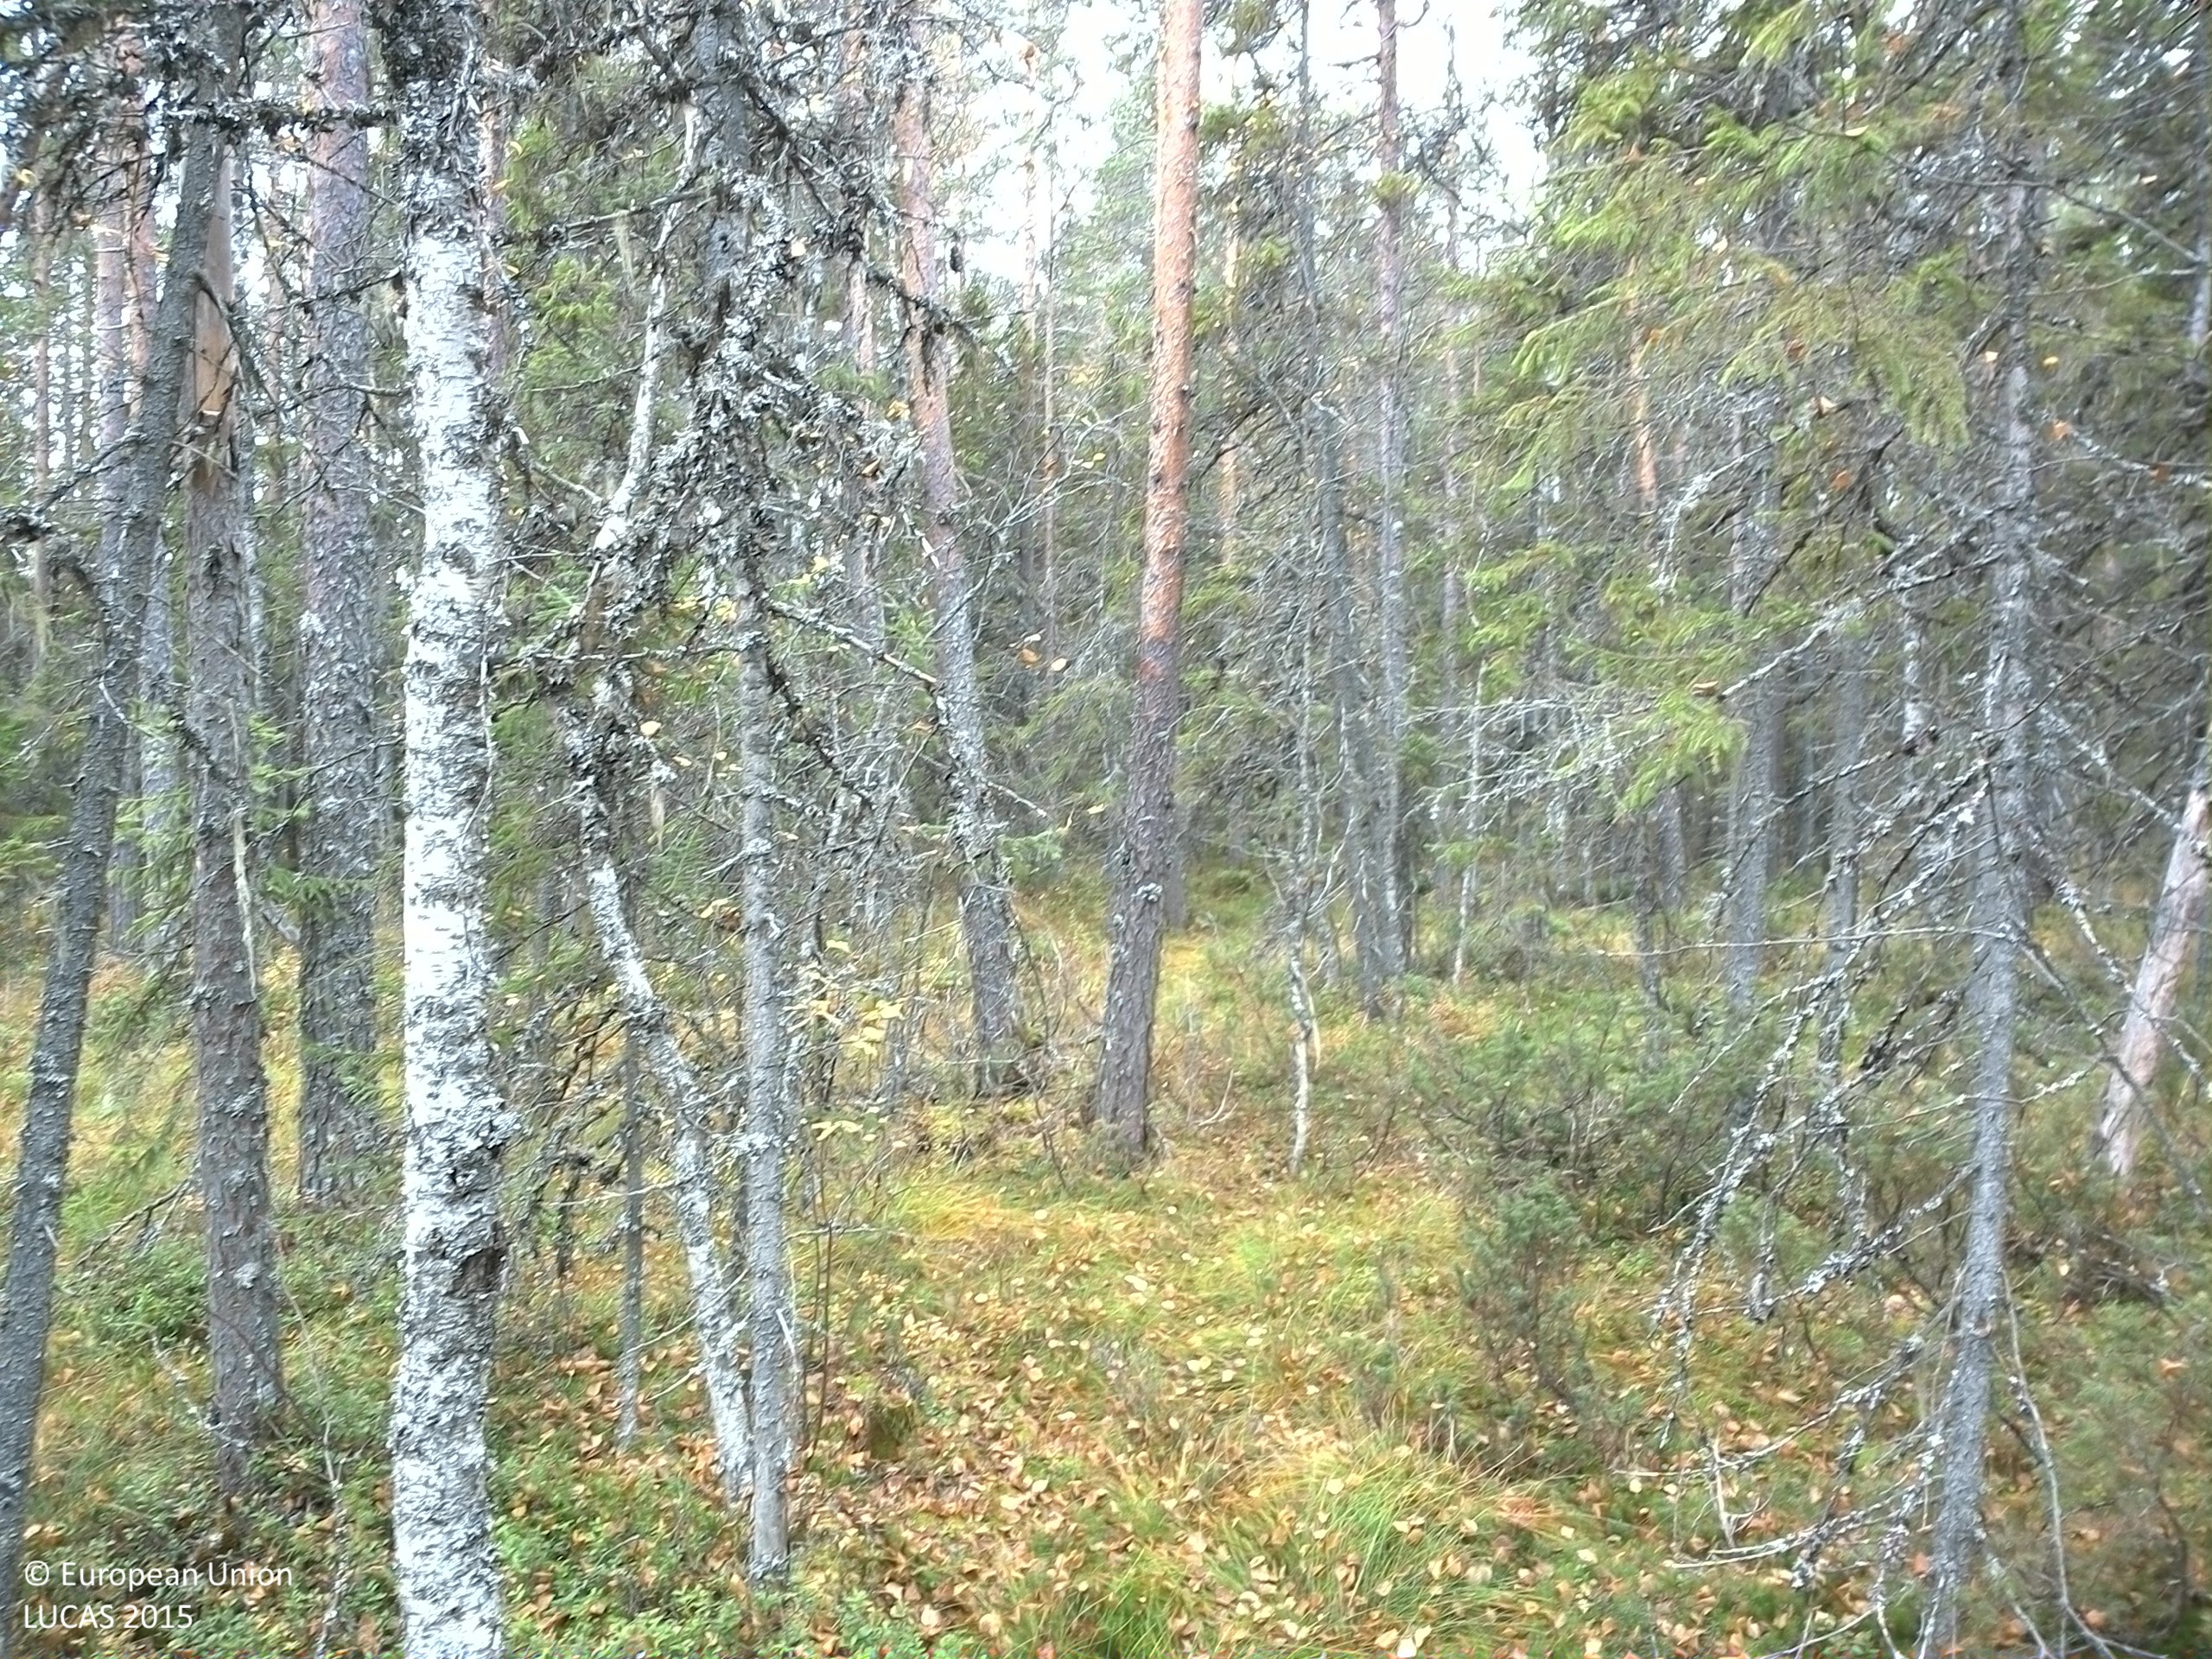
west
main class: Woodland
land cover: Pine dominated mixed woodland
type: boreal forest
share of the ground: 50 - 75 %
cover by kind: coniferous forest trees 35 %, shrubs 20 %, lichens and mosses 20 %, broadleaved forest trees 15 %, herbaceous plants 10 %
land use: Forestry
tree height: > 5 m
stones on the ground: < 10 %
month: October
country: SE
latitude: 61.2527
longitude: 14.2546
